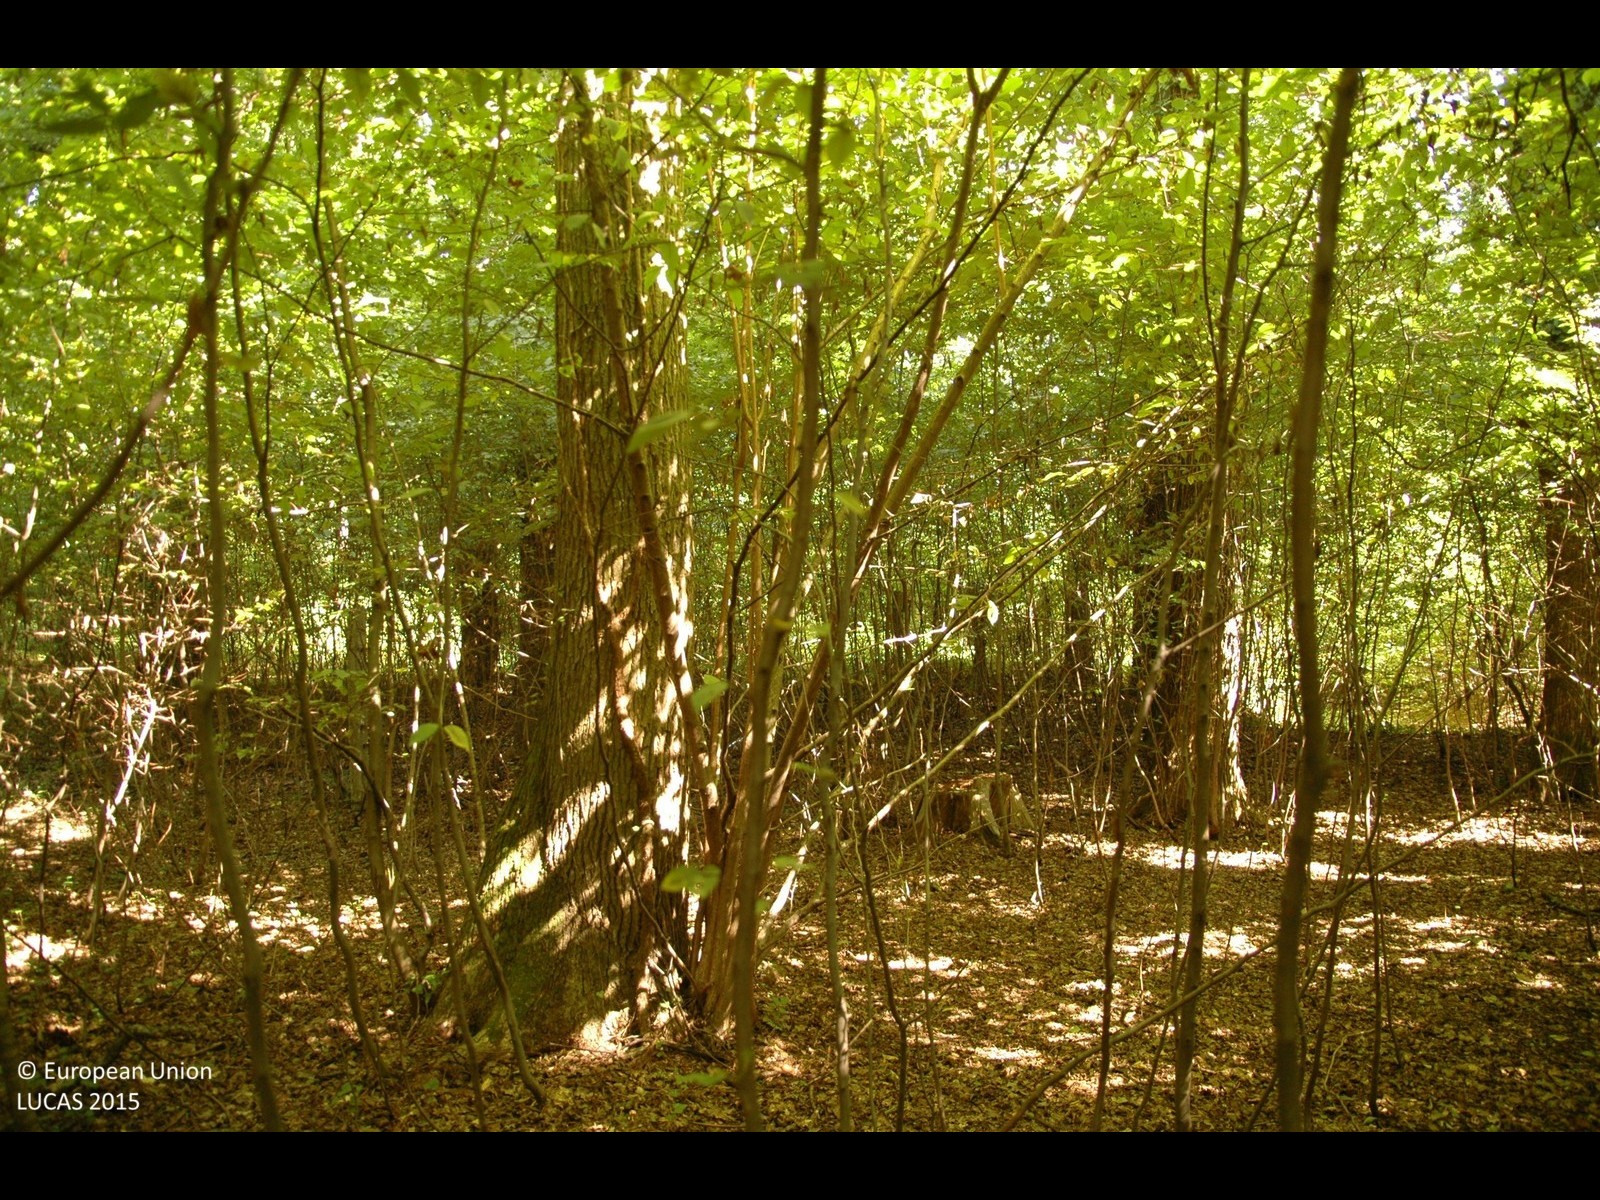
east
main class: Woodland
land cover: Broadleaved woodland
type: mesophytic deciduous forest
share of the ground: > 75 %
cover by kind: broadleaved forest trees 100 %
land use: Semi-natural and natural areas not in use
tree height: > 5 m
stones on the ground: < 10 %
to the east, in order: Broadleaved woodland; Fences; Broadleaved woodland; Fences; Broadleaved woodland; Artificial constructions in urban areas; Broadleaved woodland; Fences; Broadleaved woodland; Fences; Broadleaved woodland; Grassland without tree/shrub cover; Ditches and canals; Grassland without tree/shrub cover
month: August
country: HR
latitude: 46.1529
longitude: 16.7989
